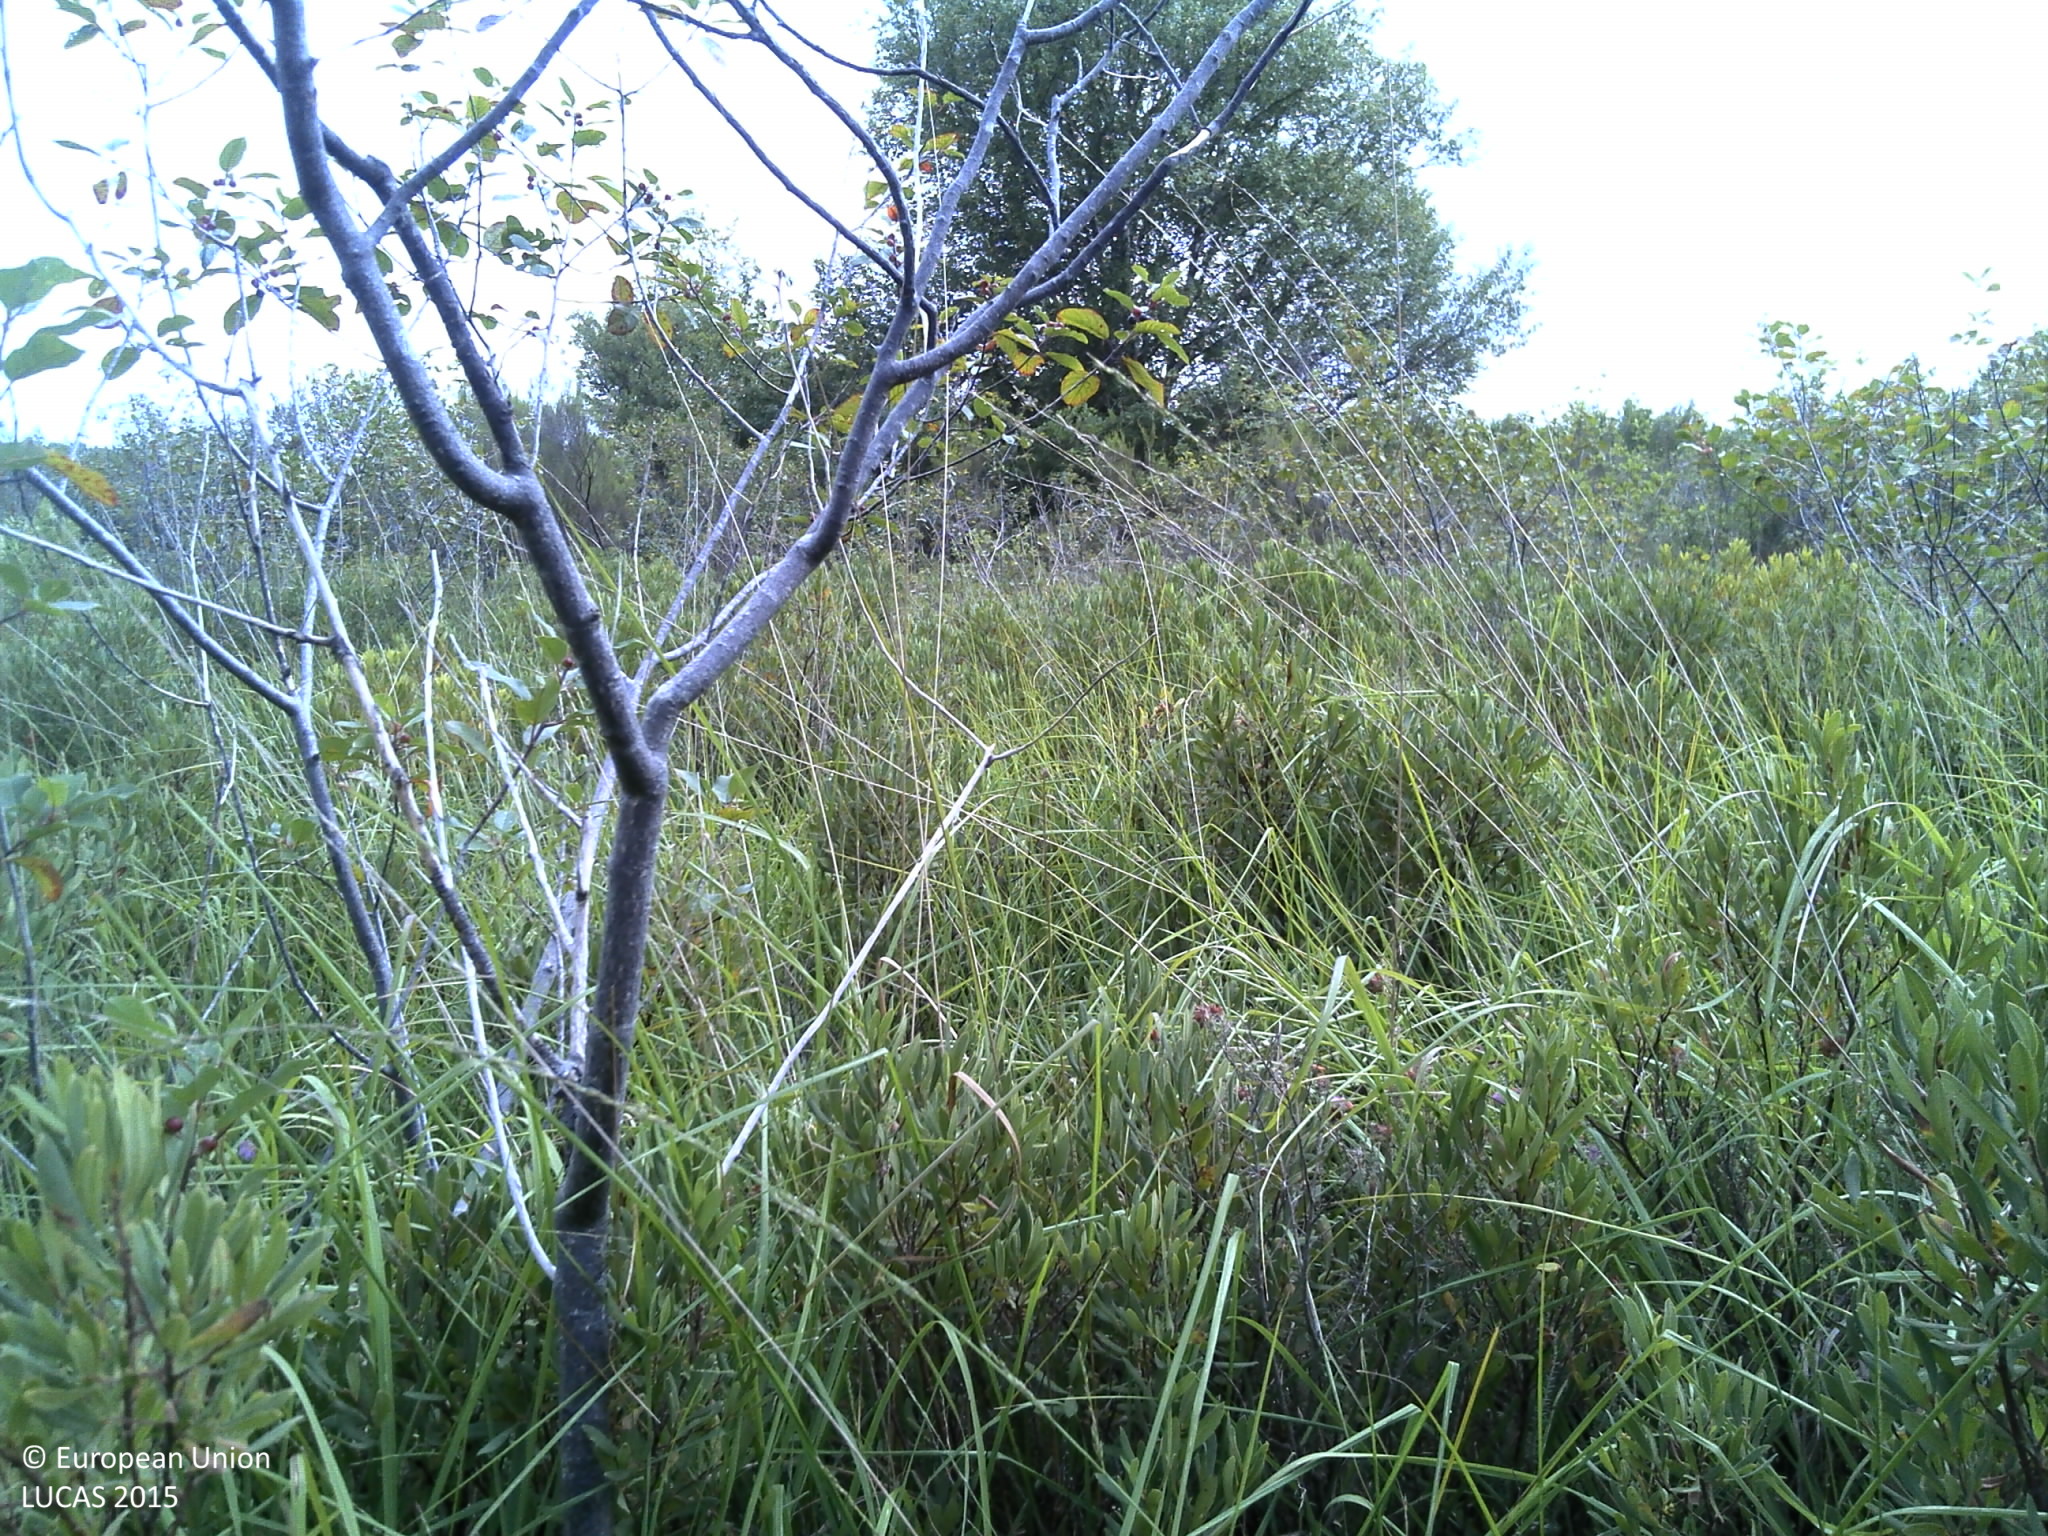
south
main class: Shrubland
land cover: Shrubland without tree cover
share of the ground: > 75 %
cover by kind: shrubs 80 %, herbaceous plants 20 %
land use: Semi-natural and natural areas not in use
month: August
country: FR
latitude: 44.6216
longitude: -0.9732
